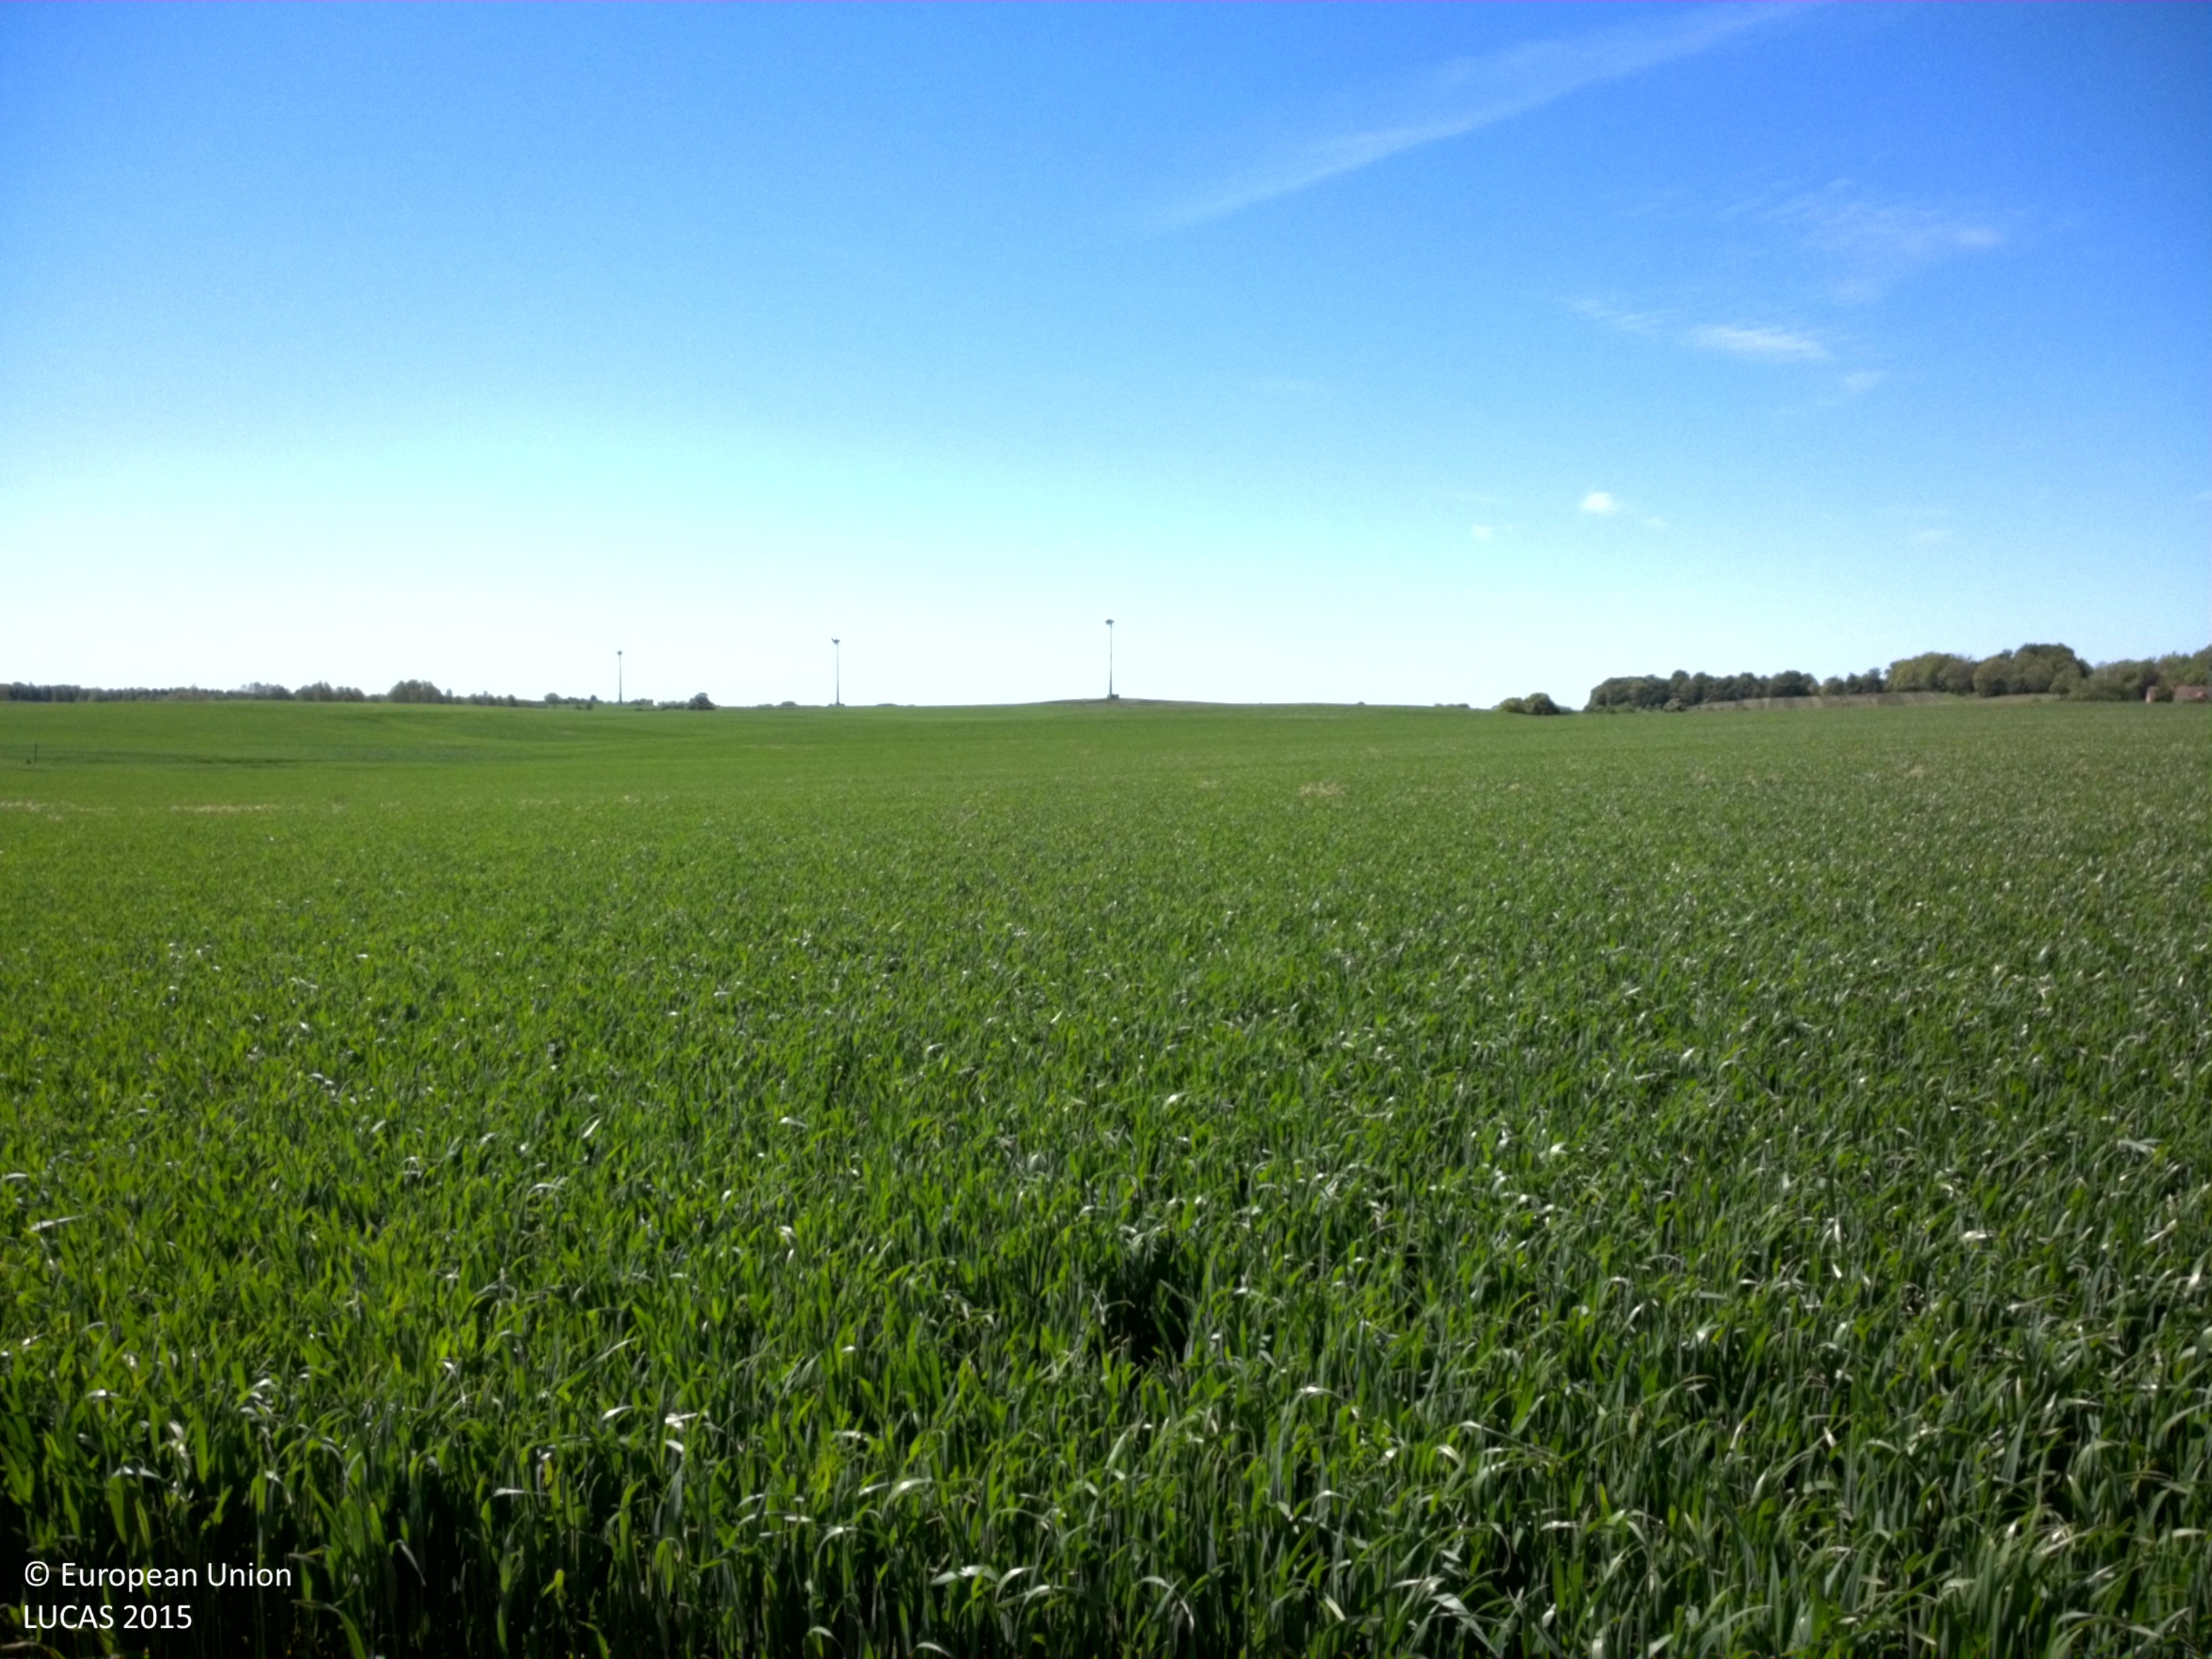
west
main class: Cropland
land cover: Common wheat
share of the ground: > 75 %
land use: Agriculture (excluding fallow land and kitchen gardens)
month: June
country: SE
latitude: 55.4871
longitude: 13.6857
